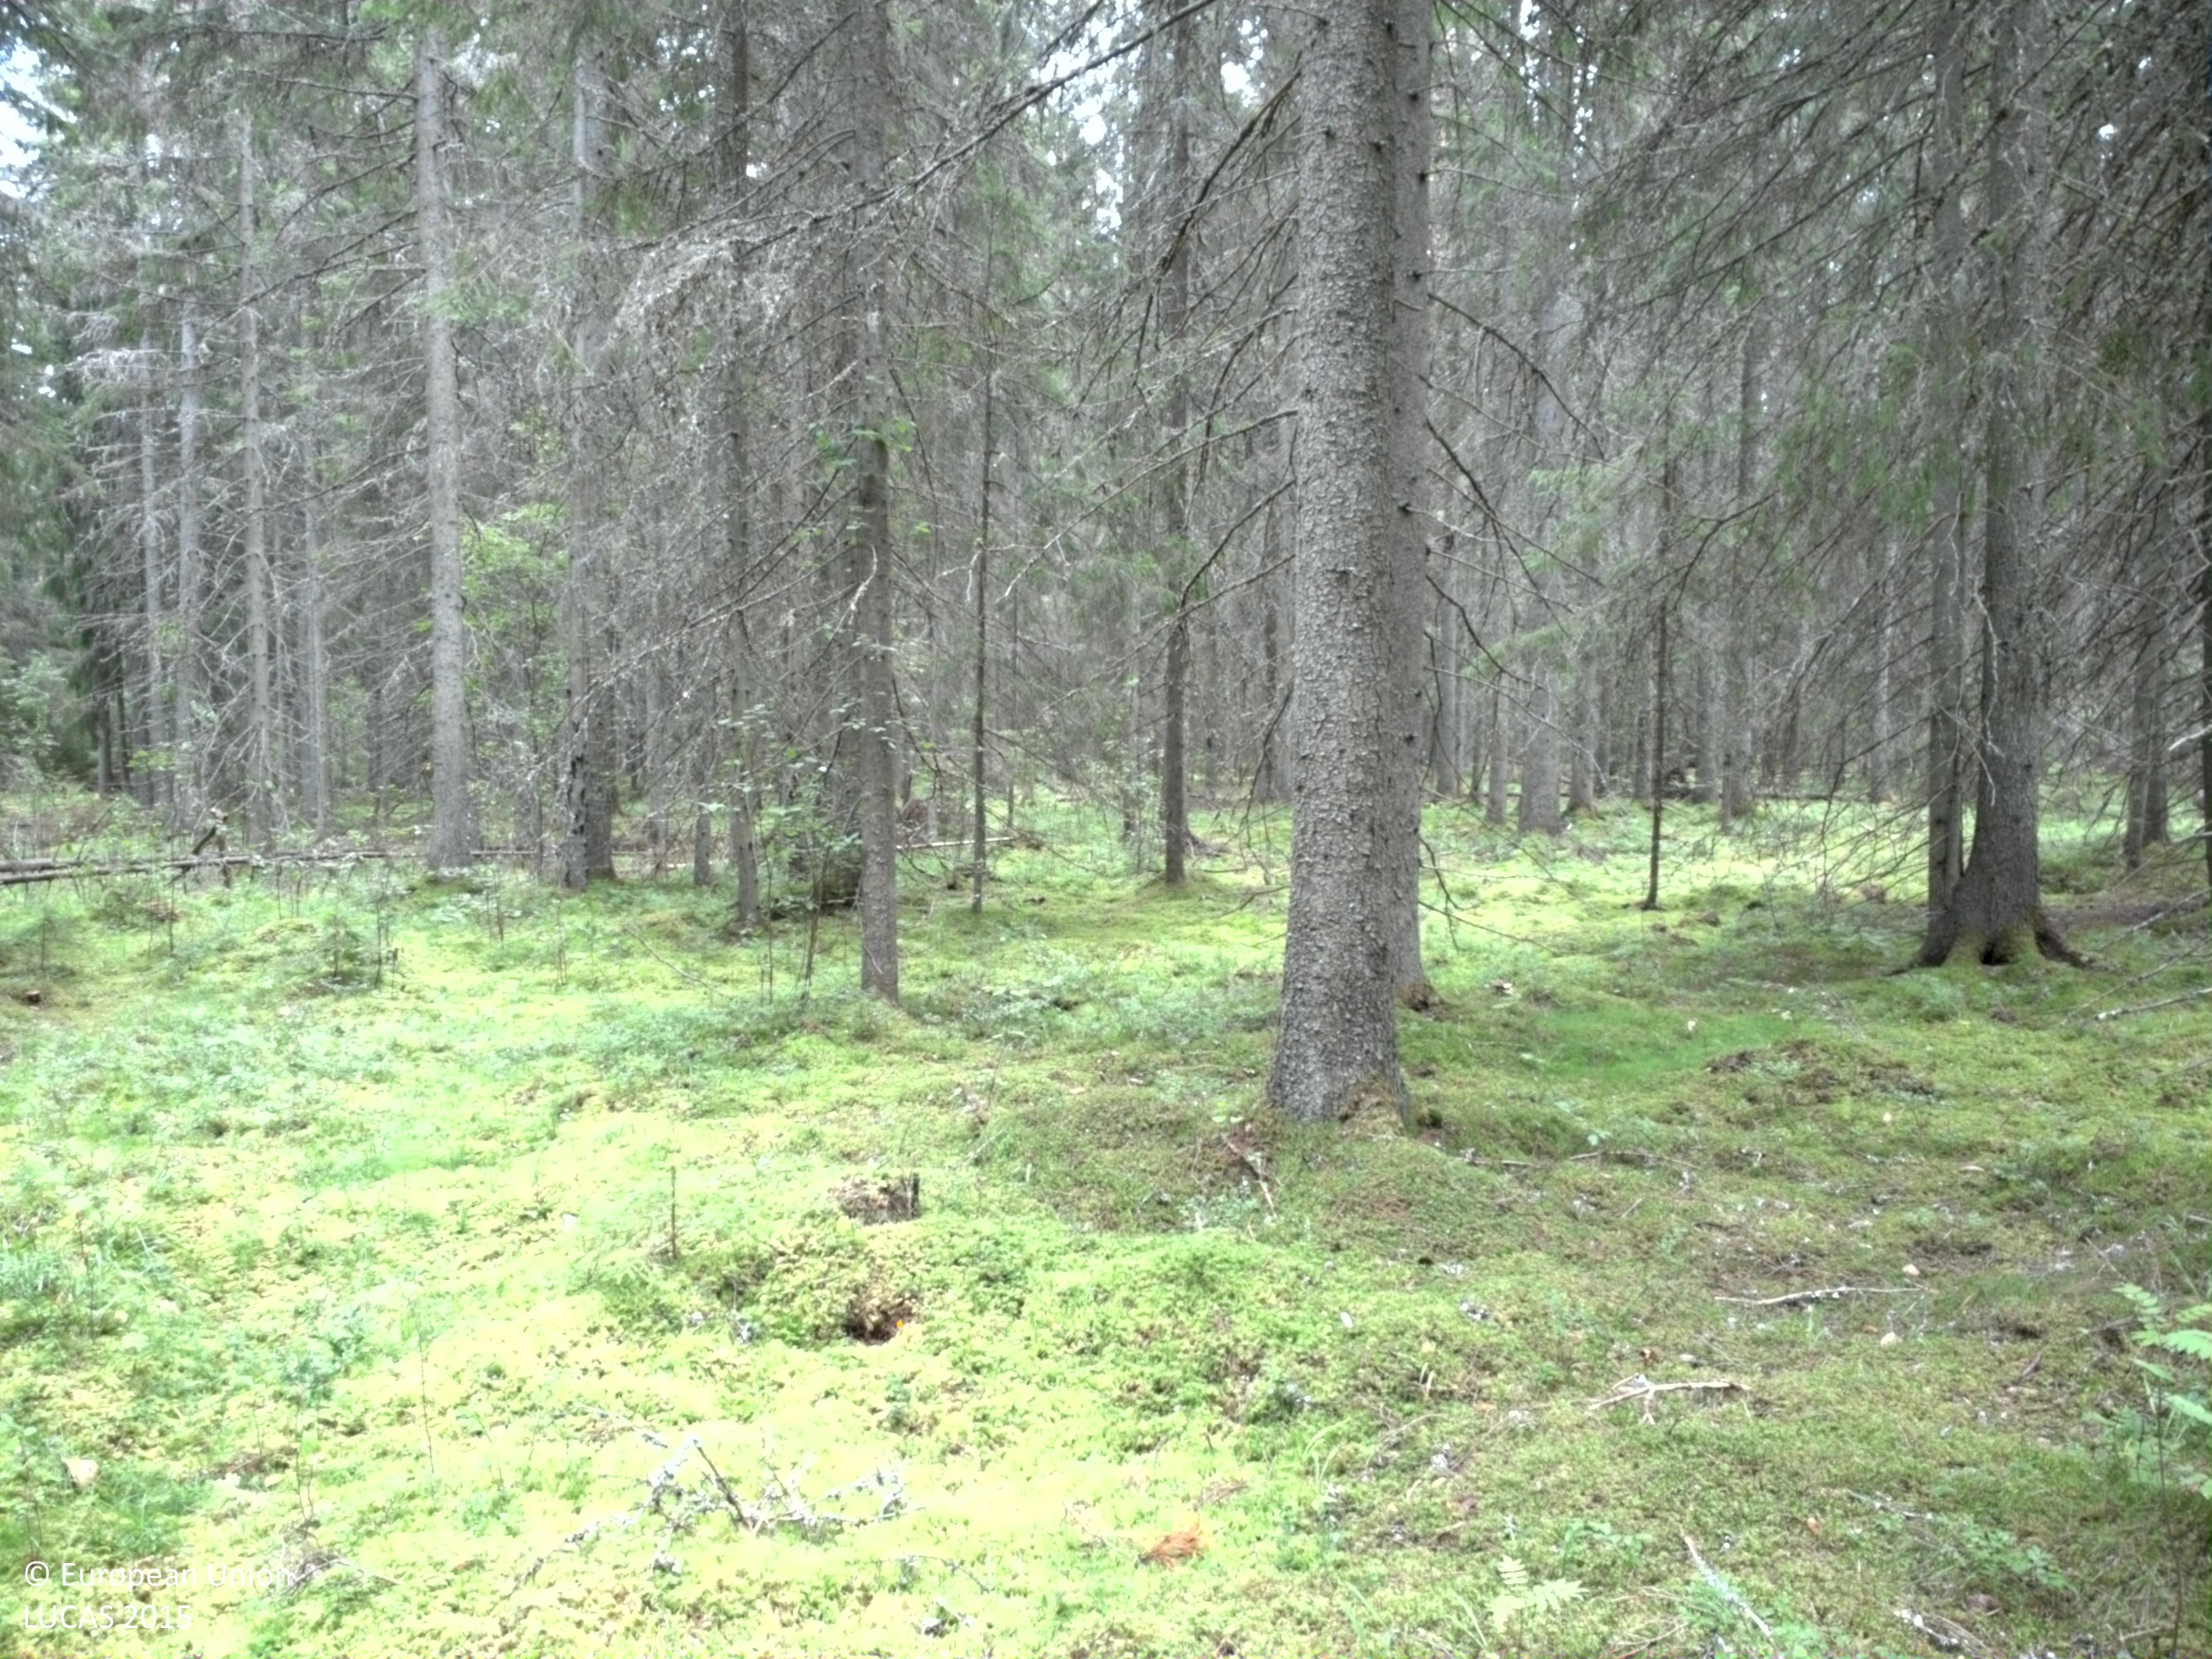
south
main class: Woodland
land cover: Spruce dominated coniferous woodland
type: boreal forest
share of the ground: > 75 %
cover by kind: coniferous forest trees 80 %, lichens and mosses 10 %, broadleaved forest trees 5 %, shrubs 5 %
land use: Forestry
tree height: > 5 m
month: August
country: SE
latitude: 59.8890
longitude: 16.4421
